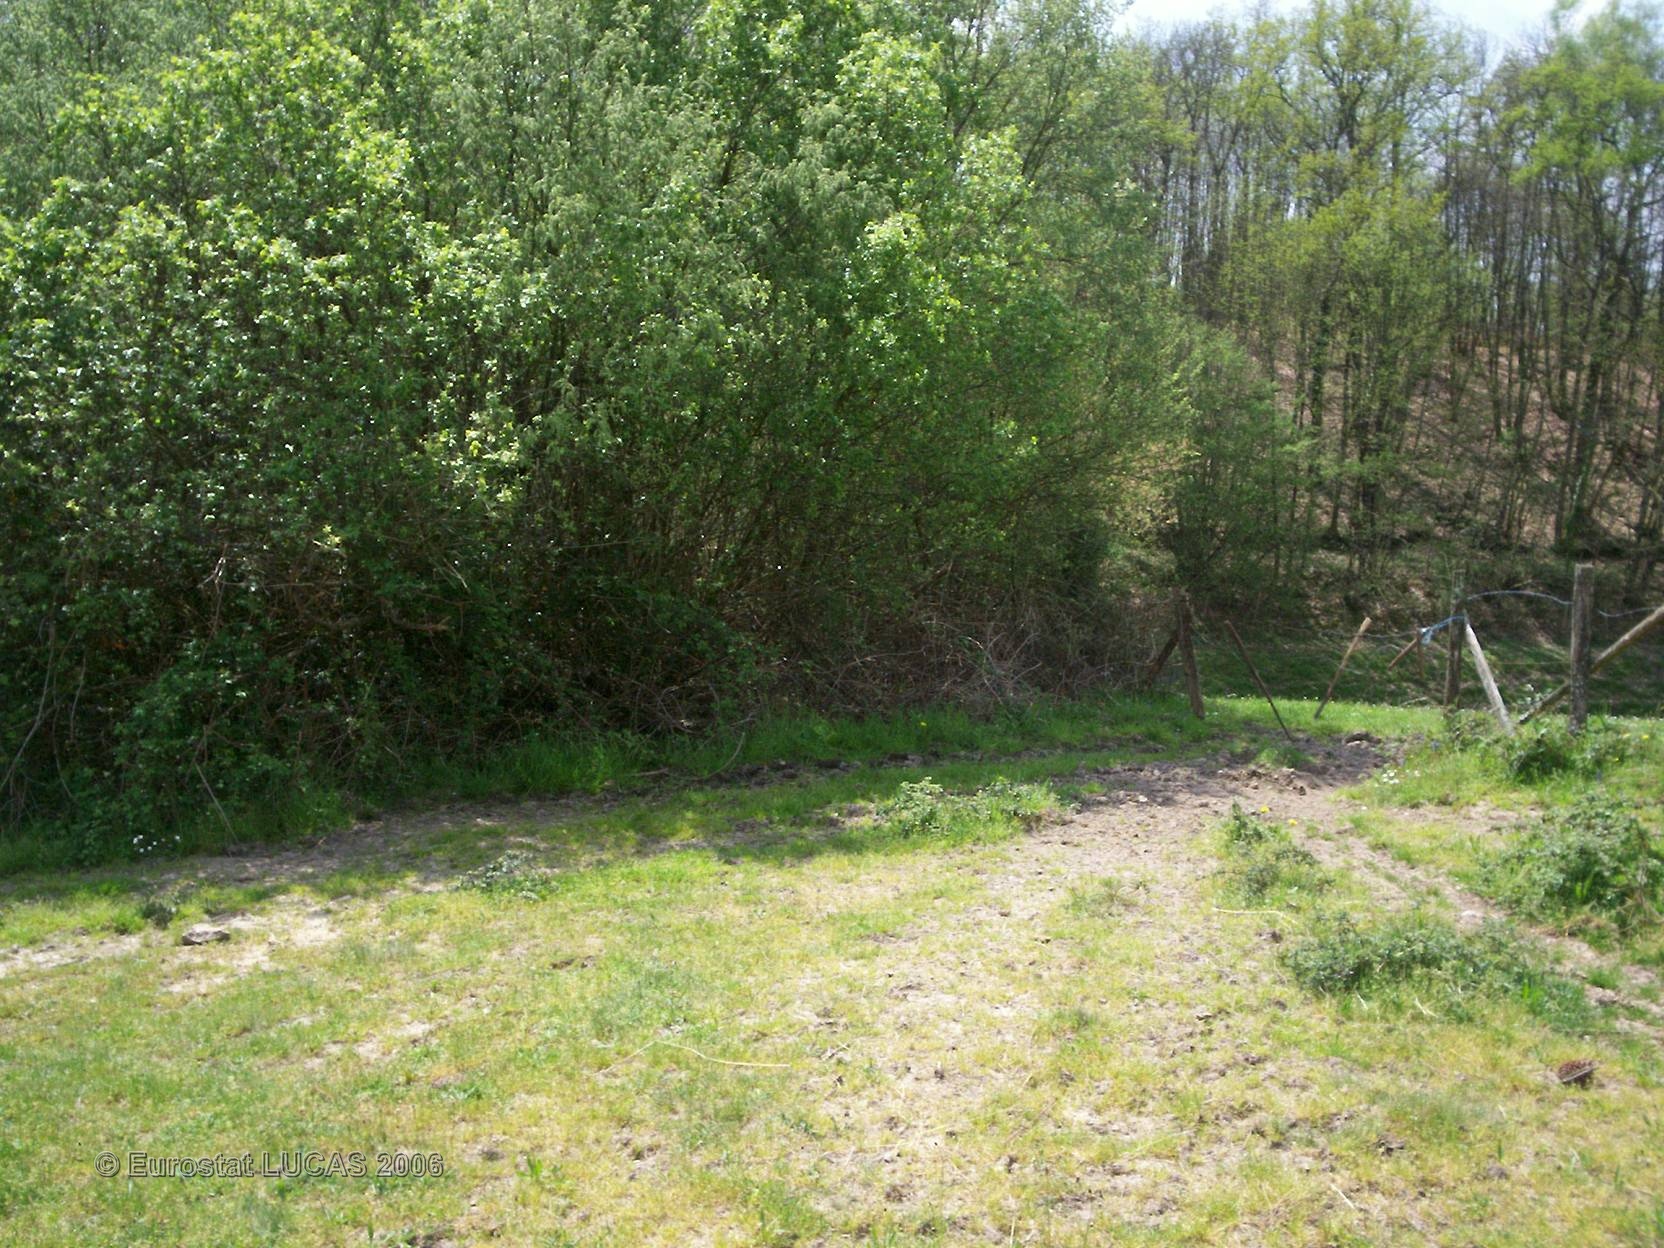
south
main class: Grassland
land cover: Grassland with sparse tree/shrub cover
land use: Agriculture (excluding fallow land and kitchen gardens)
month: April
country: FR
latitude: 45.5533
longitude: 0.7786
